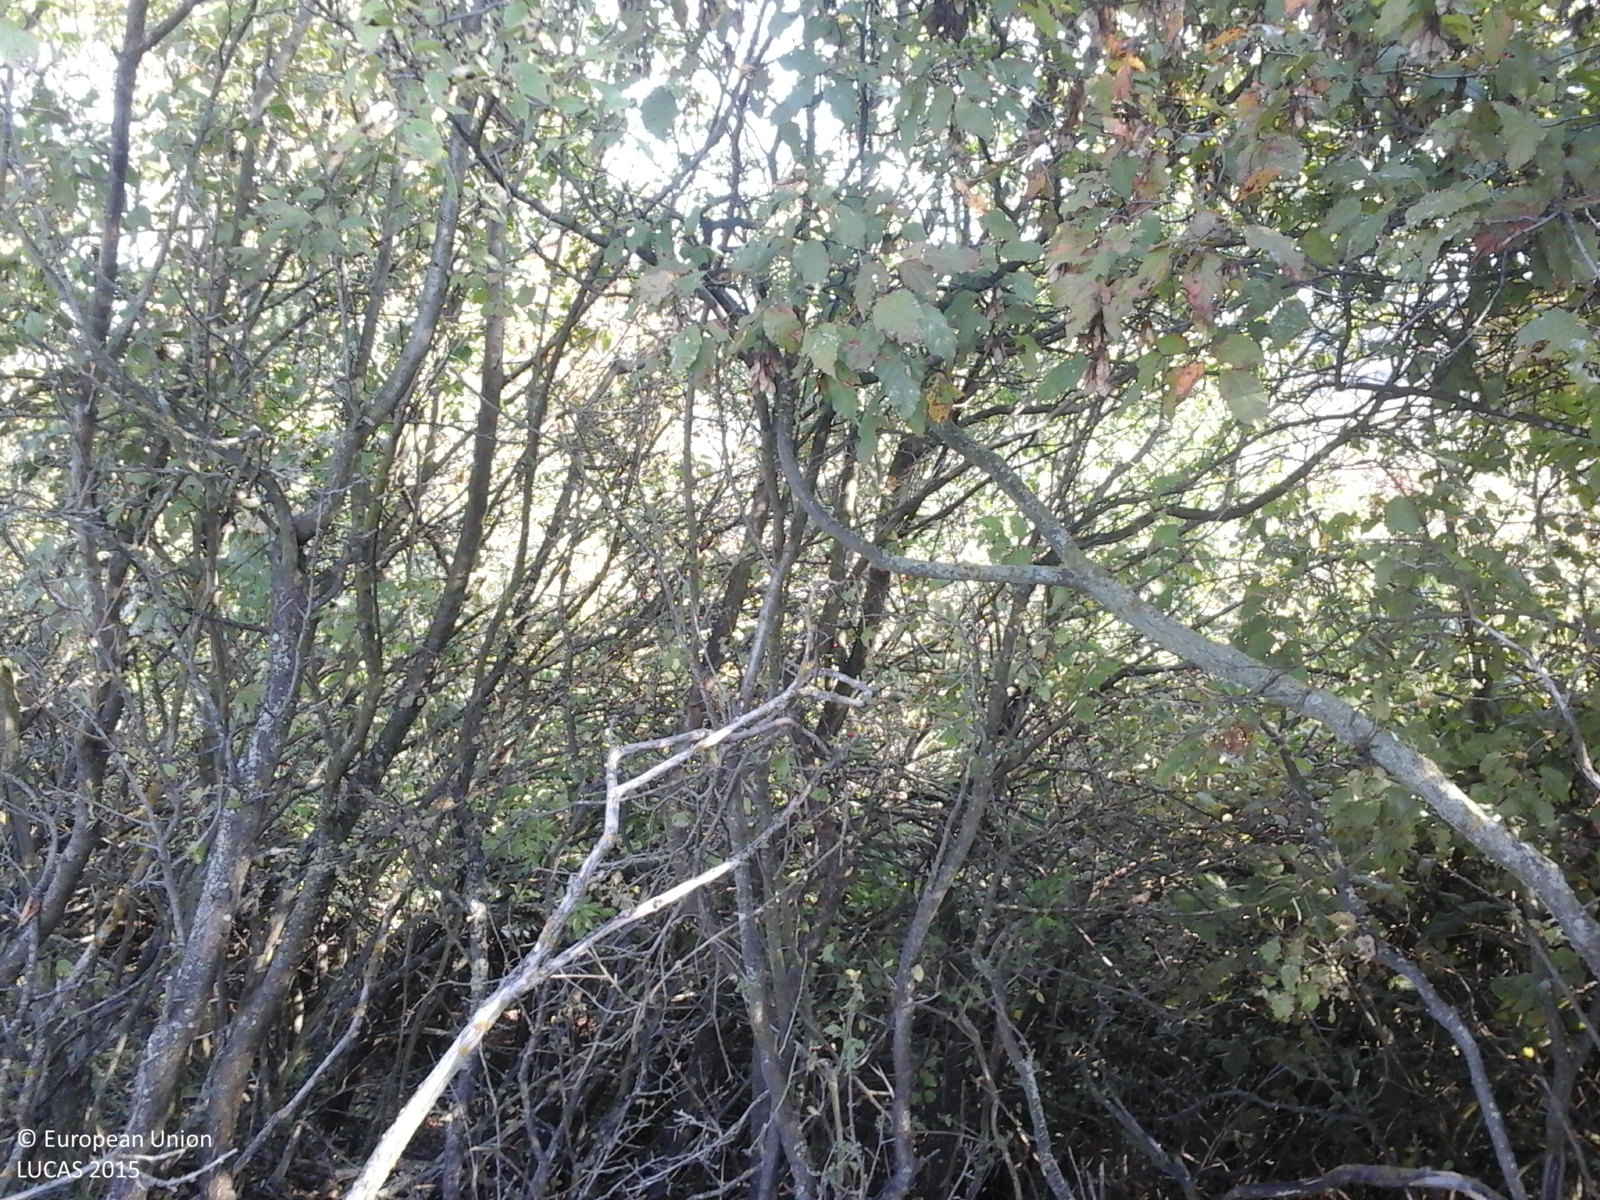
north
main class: Shrubland
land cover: Shrubland without tree cover
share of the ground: > 75 %
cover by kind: shrubs 100 %
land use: Semi-natural and natural areas not in use
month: October
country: RO
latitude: 46.3851
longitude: 23.9227
